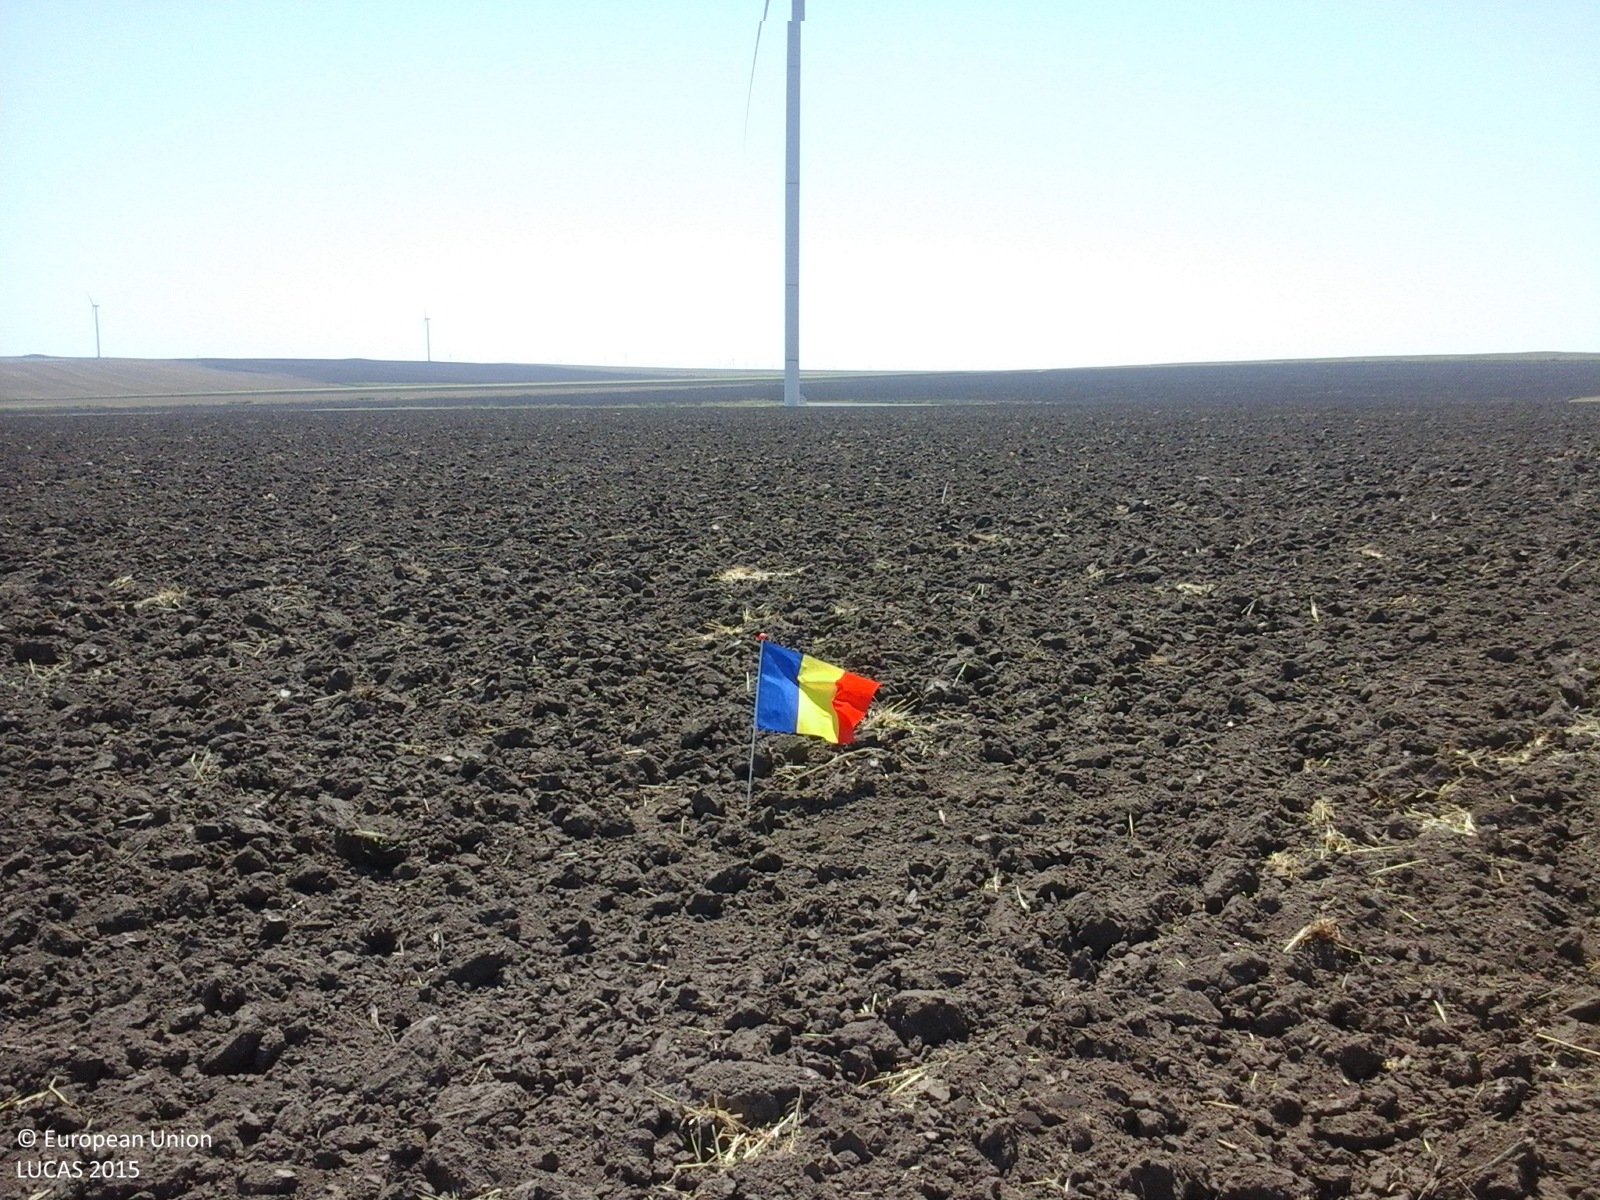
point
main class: Cropland
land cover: Barley
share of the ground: < 10 %
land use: Agriculture (excluding fallow land and kitchen gardens)
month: August
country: RO
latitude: 44.5941
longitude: 28.2697
